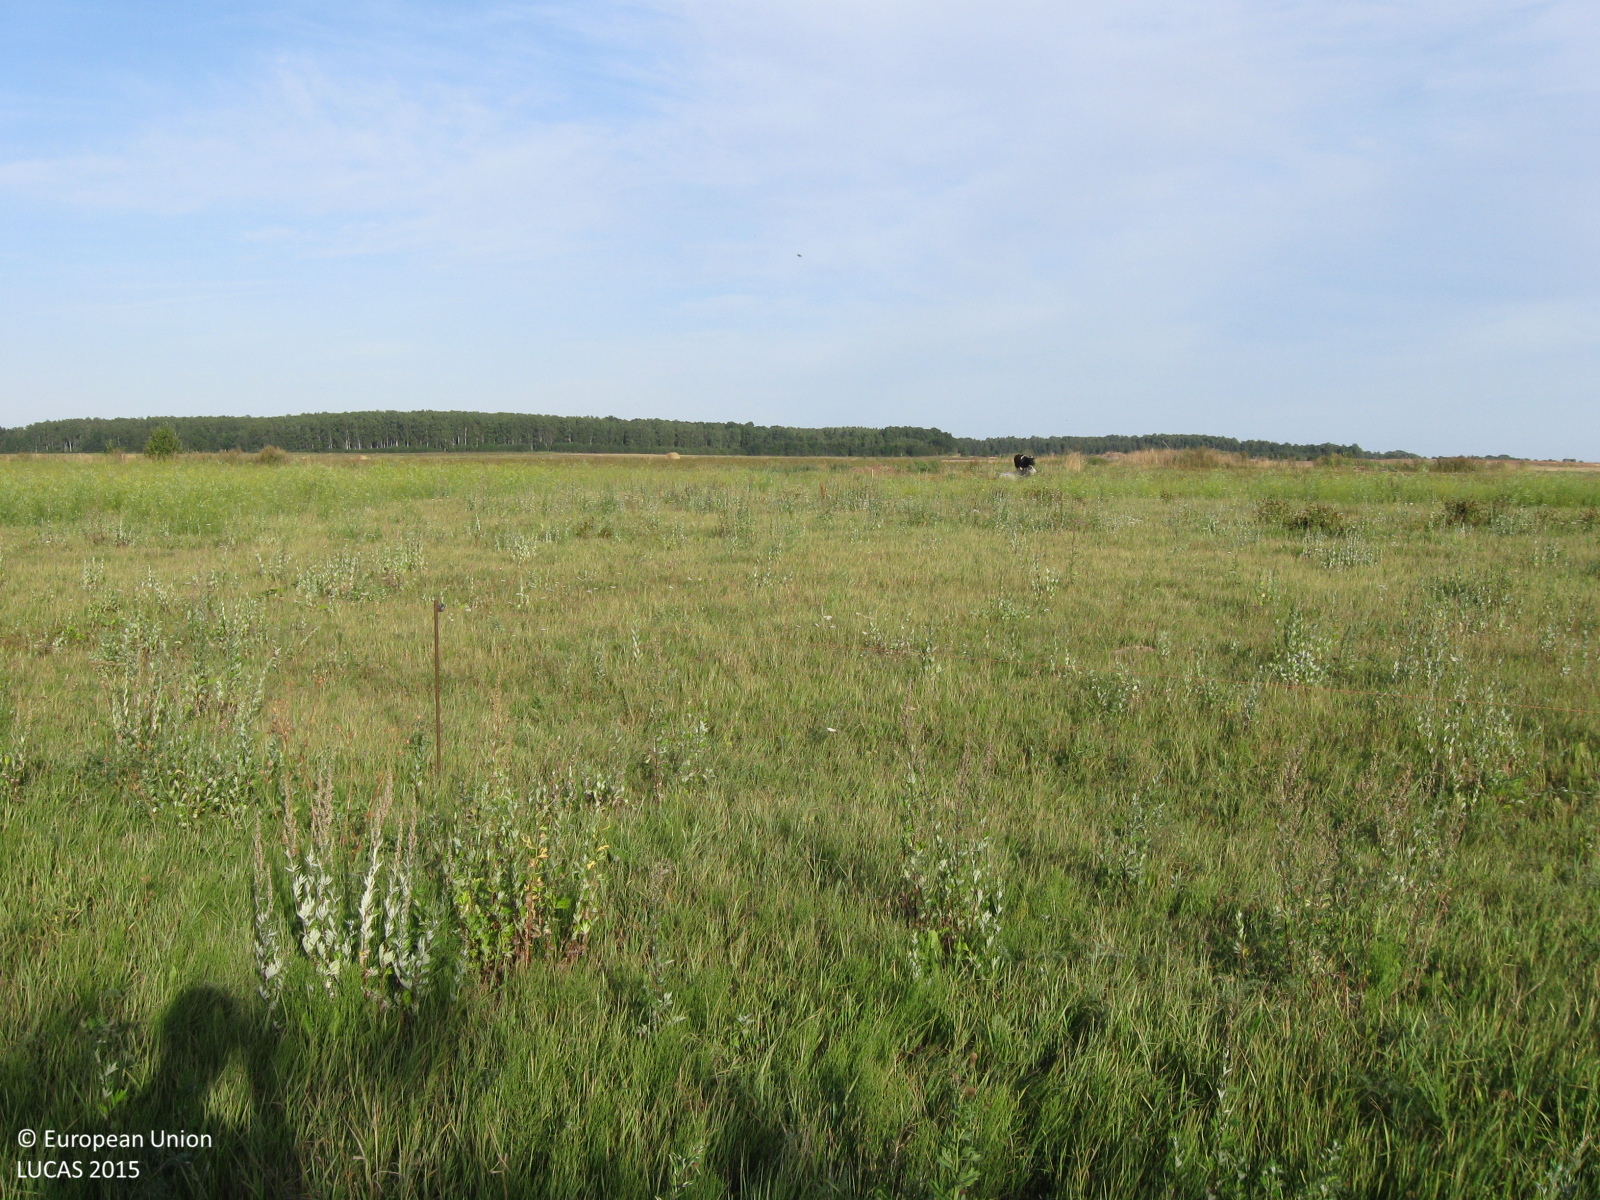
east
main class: Grassland
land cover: Grassland without tree/shrub cover
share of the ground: > 75 %
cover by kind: herbaceous plants 100 %
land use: Agriculture (excluding fallow land and kitchen gardens)
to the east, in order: Grassland without tree/shrub cover; Fences; Grassland without tree/shrub cover; Fences; Grassland without tree/shrub cover; Other leguminous and mixtures for fodder; Common wheat
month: August
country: LT
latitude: 55.4009
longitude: 23.2924
